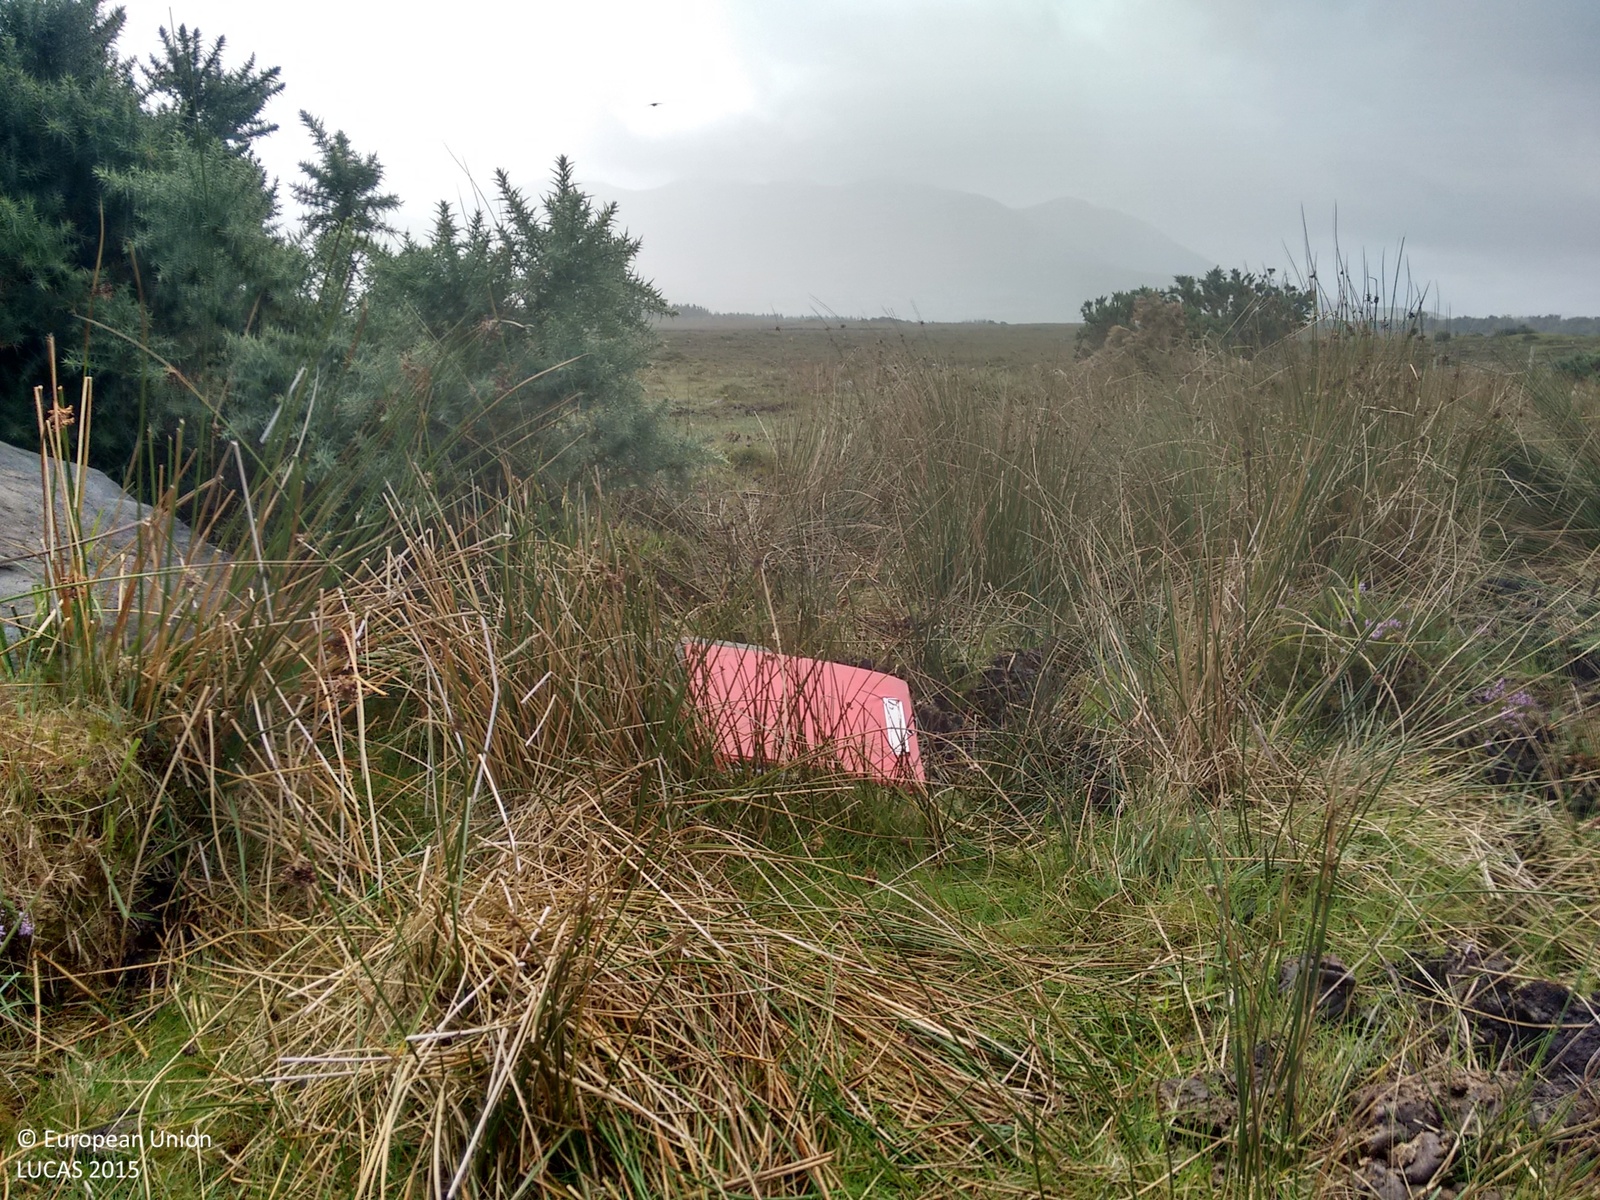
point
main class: Grassland
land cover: Grassland with sparse tree/shrub cover
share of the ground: > 75 %
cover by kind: herbaceous plants 85 %, shrubs 10 %, broadleaved forest trees 5 %
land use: Agriculture (excluding fallow land and kitchen gardens)
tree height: < 5 m
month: August
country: IE
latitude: 52.0610
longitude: -9.7747
